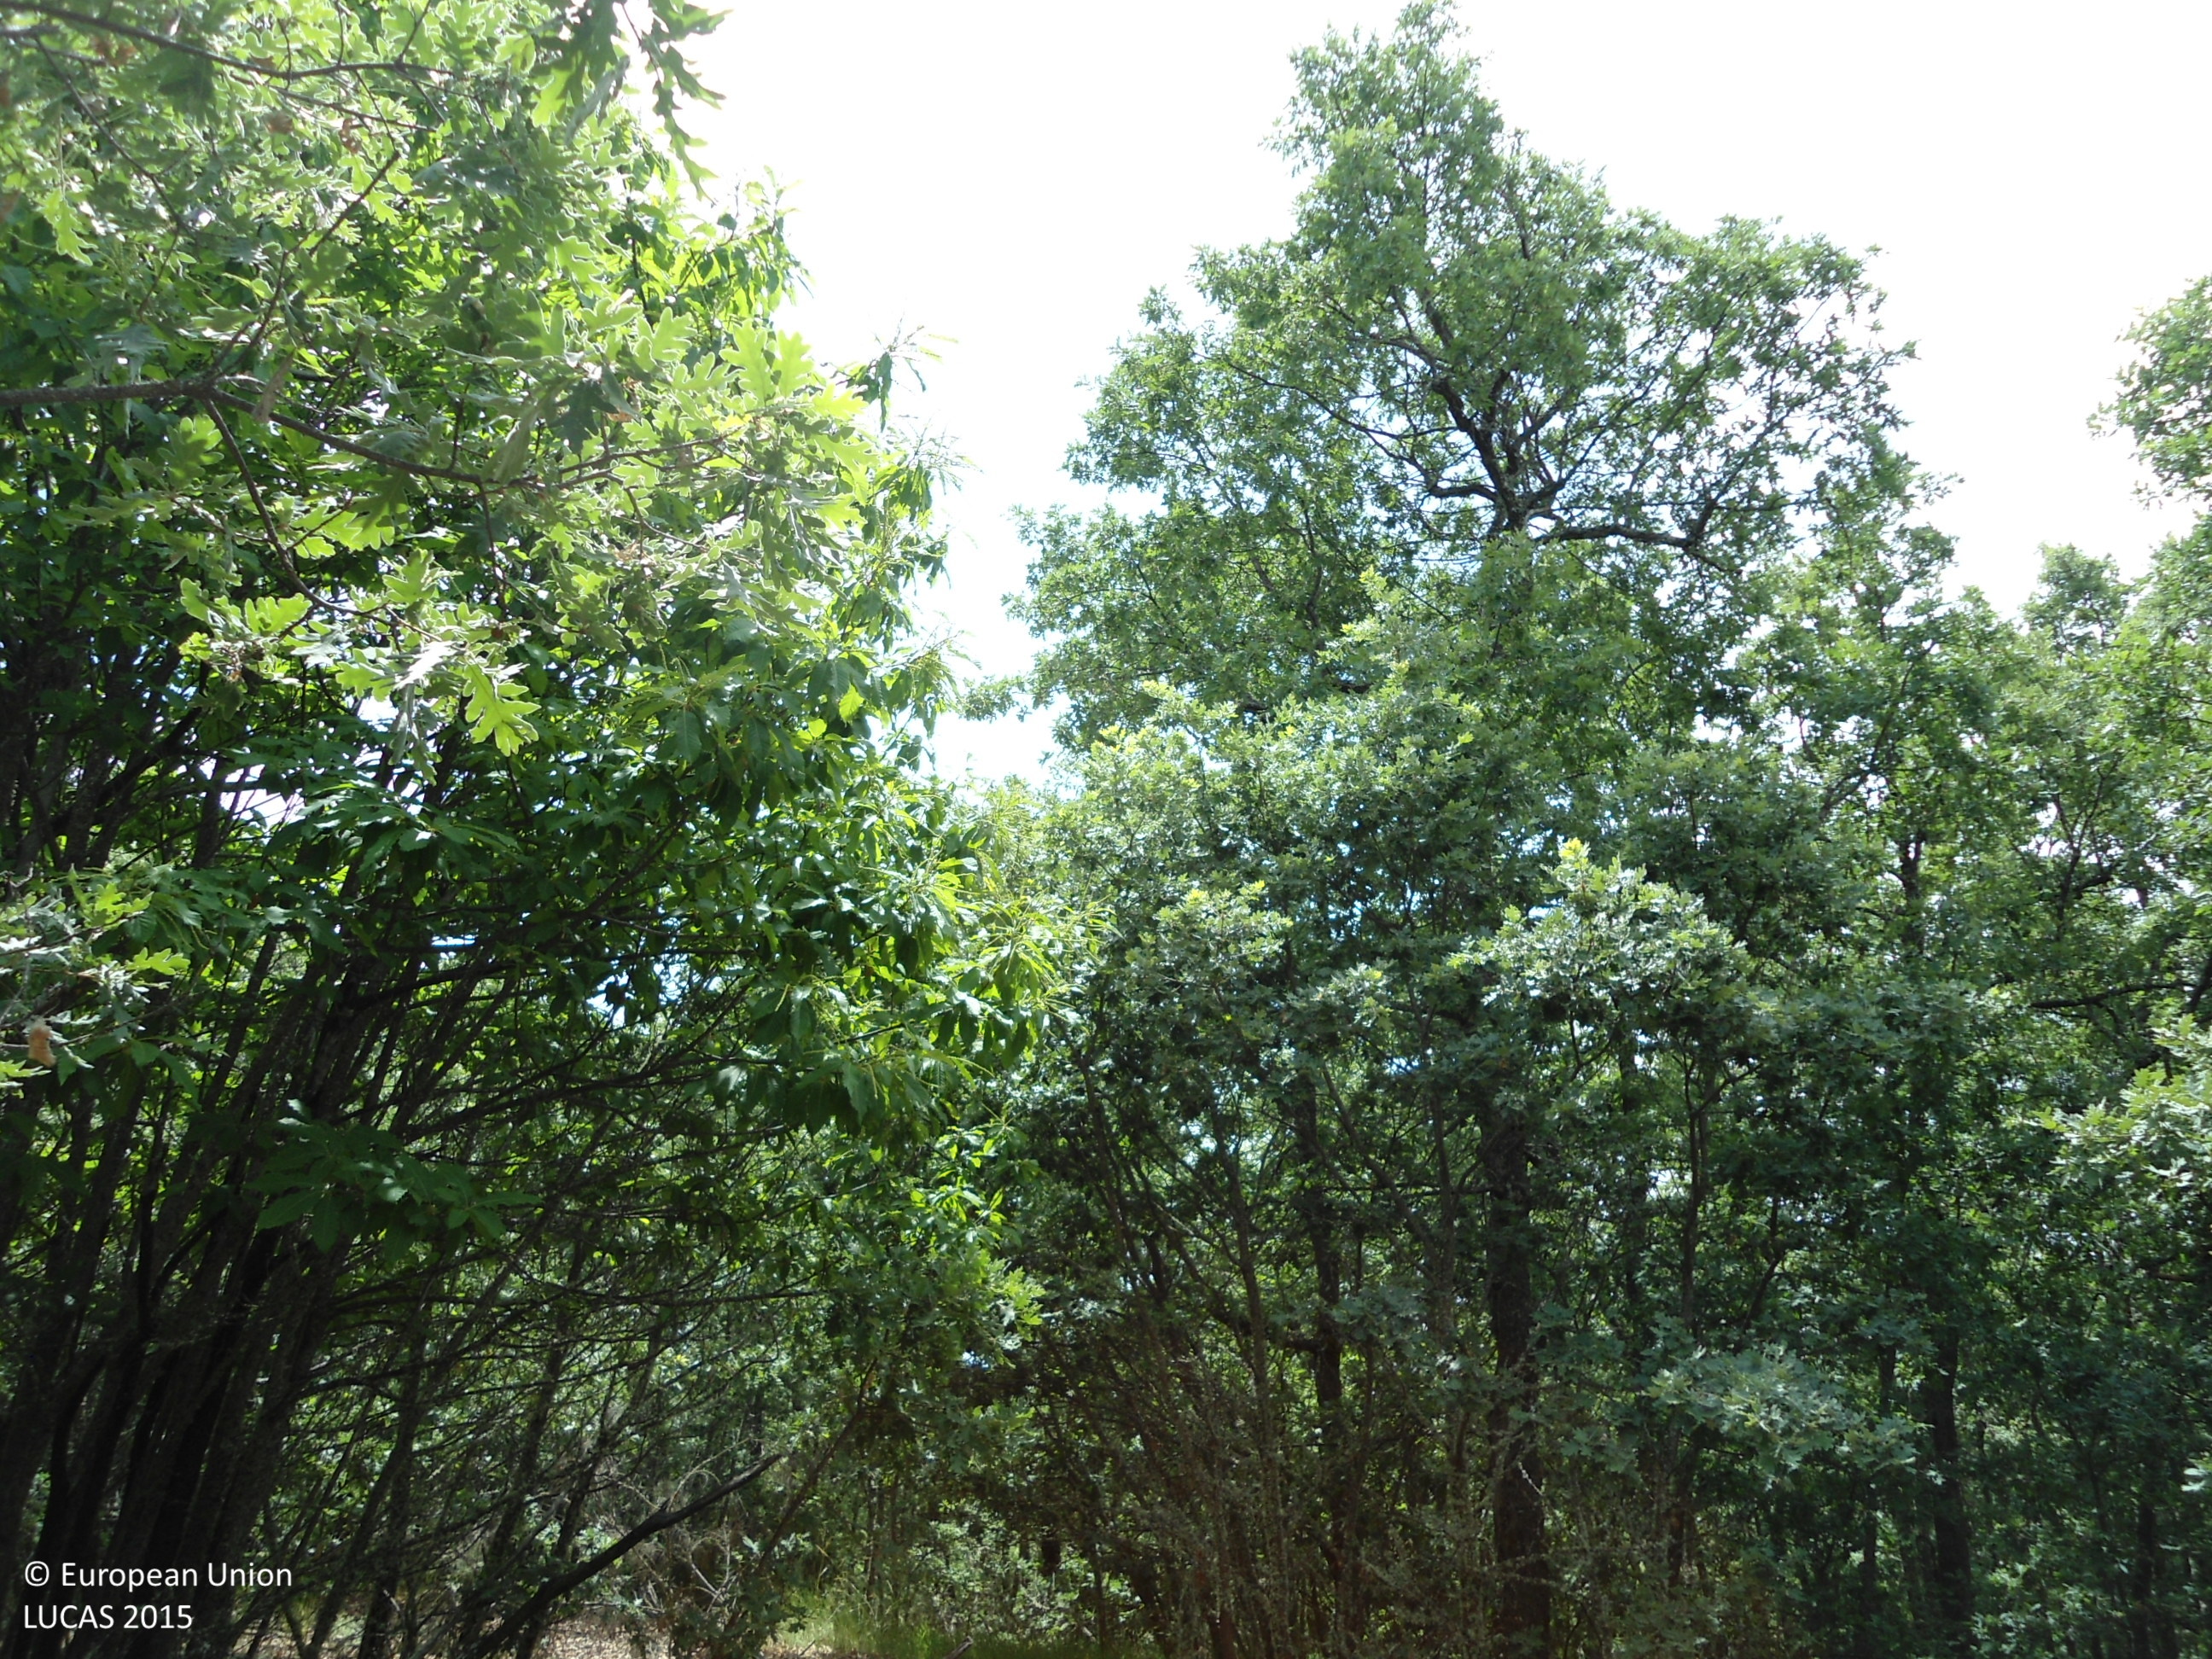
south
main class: Woodland
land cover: Broadleaved woodland
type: thermophilous deciduous forest
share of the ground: > 75 %
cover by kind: broadleaved forest trees 85 %, shrubs 10 %, herbaceous plants 5 %
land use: Forestry
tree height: > 5 m
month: June
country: ES
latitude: 42.0706
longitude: -6.5615
